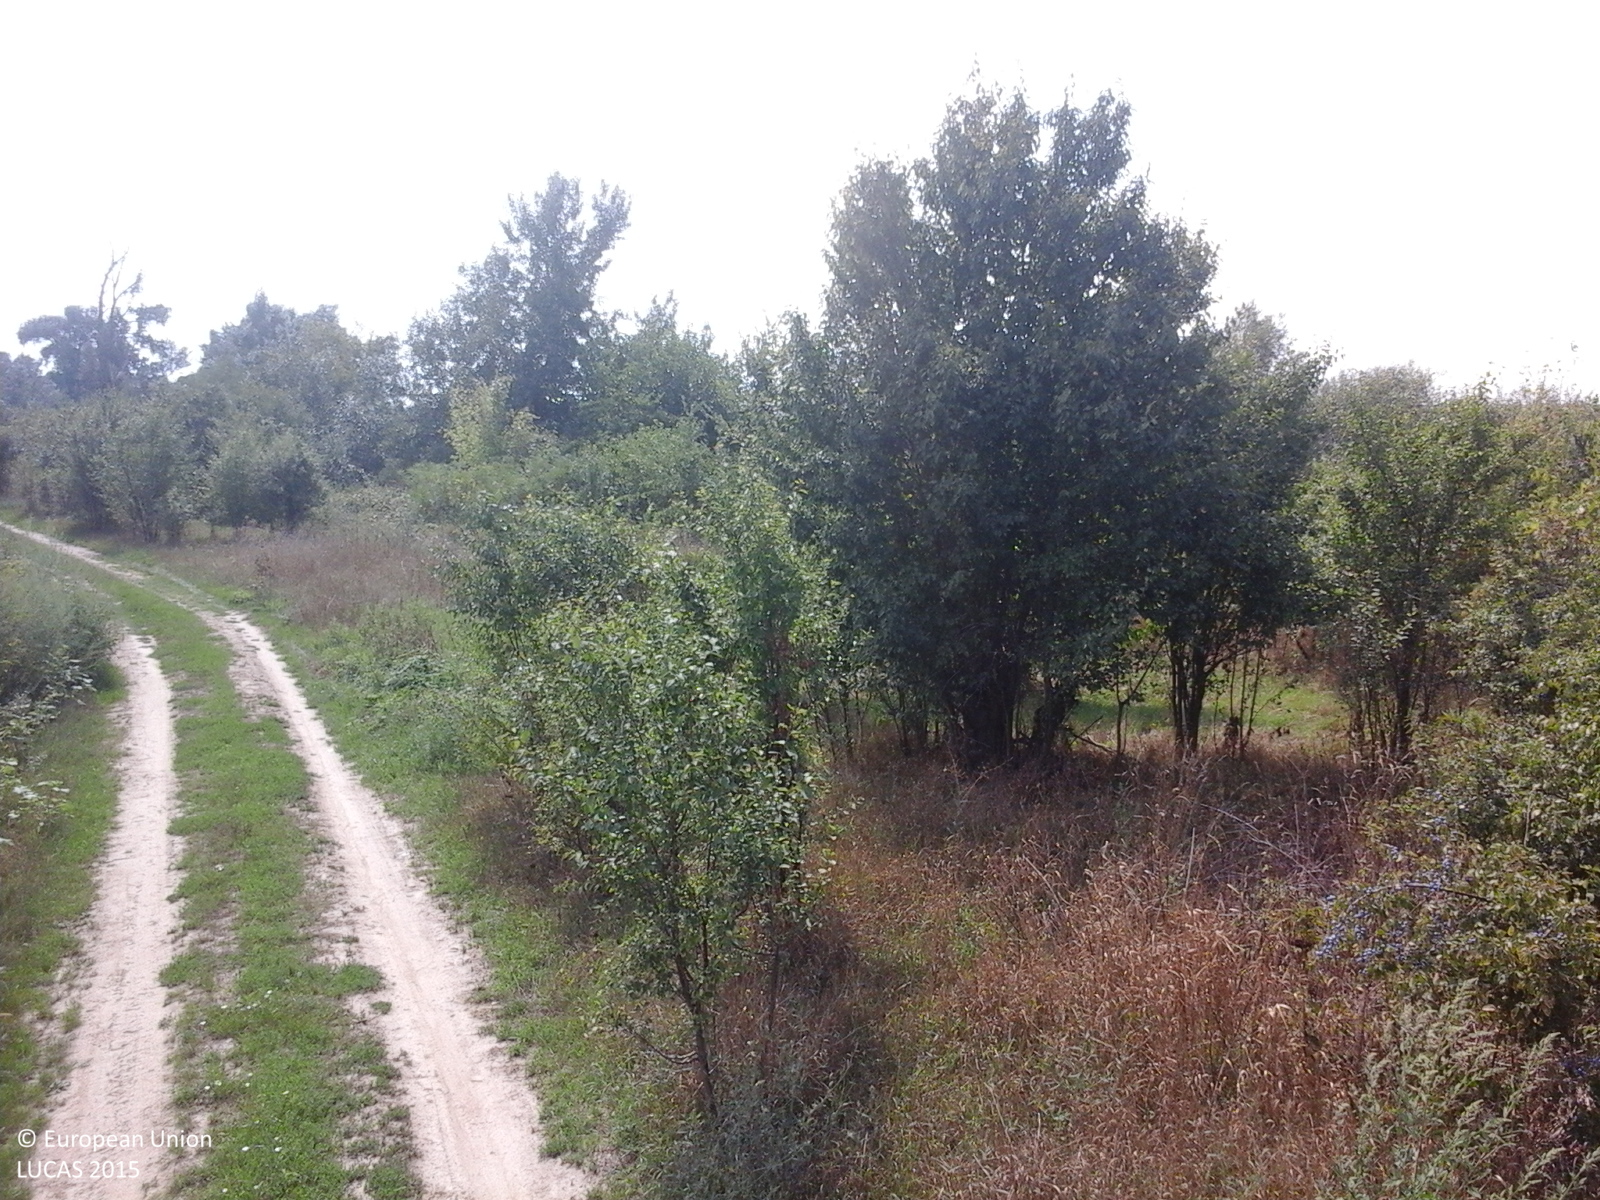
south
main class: Cropland
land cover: Maize
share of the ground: > 75 %
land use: Agriculture (excluding fallow land and kitchen gardens)
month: August
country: RO
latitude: 46.1409
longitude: 21.3876
